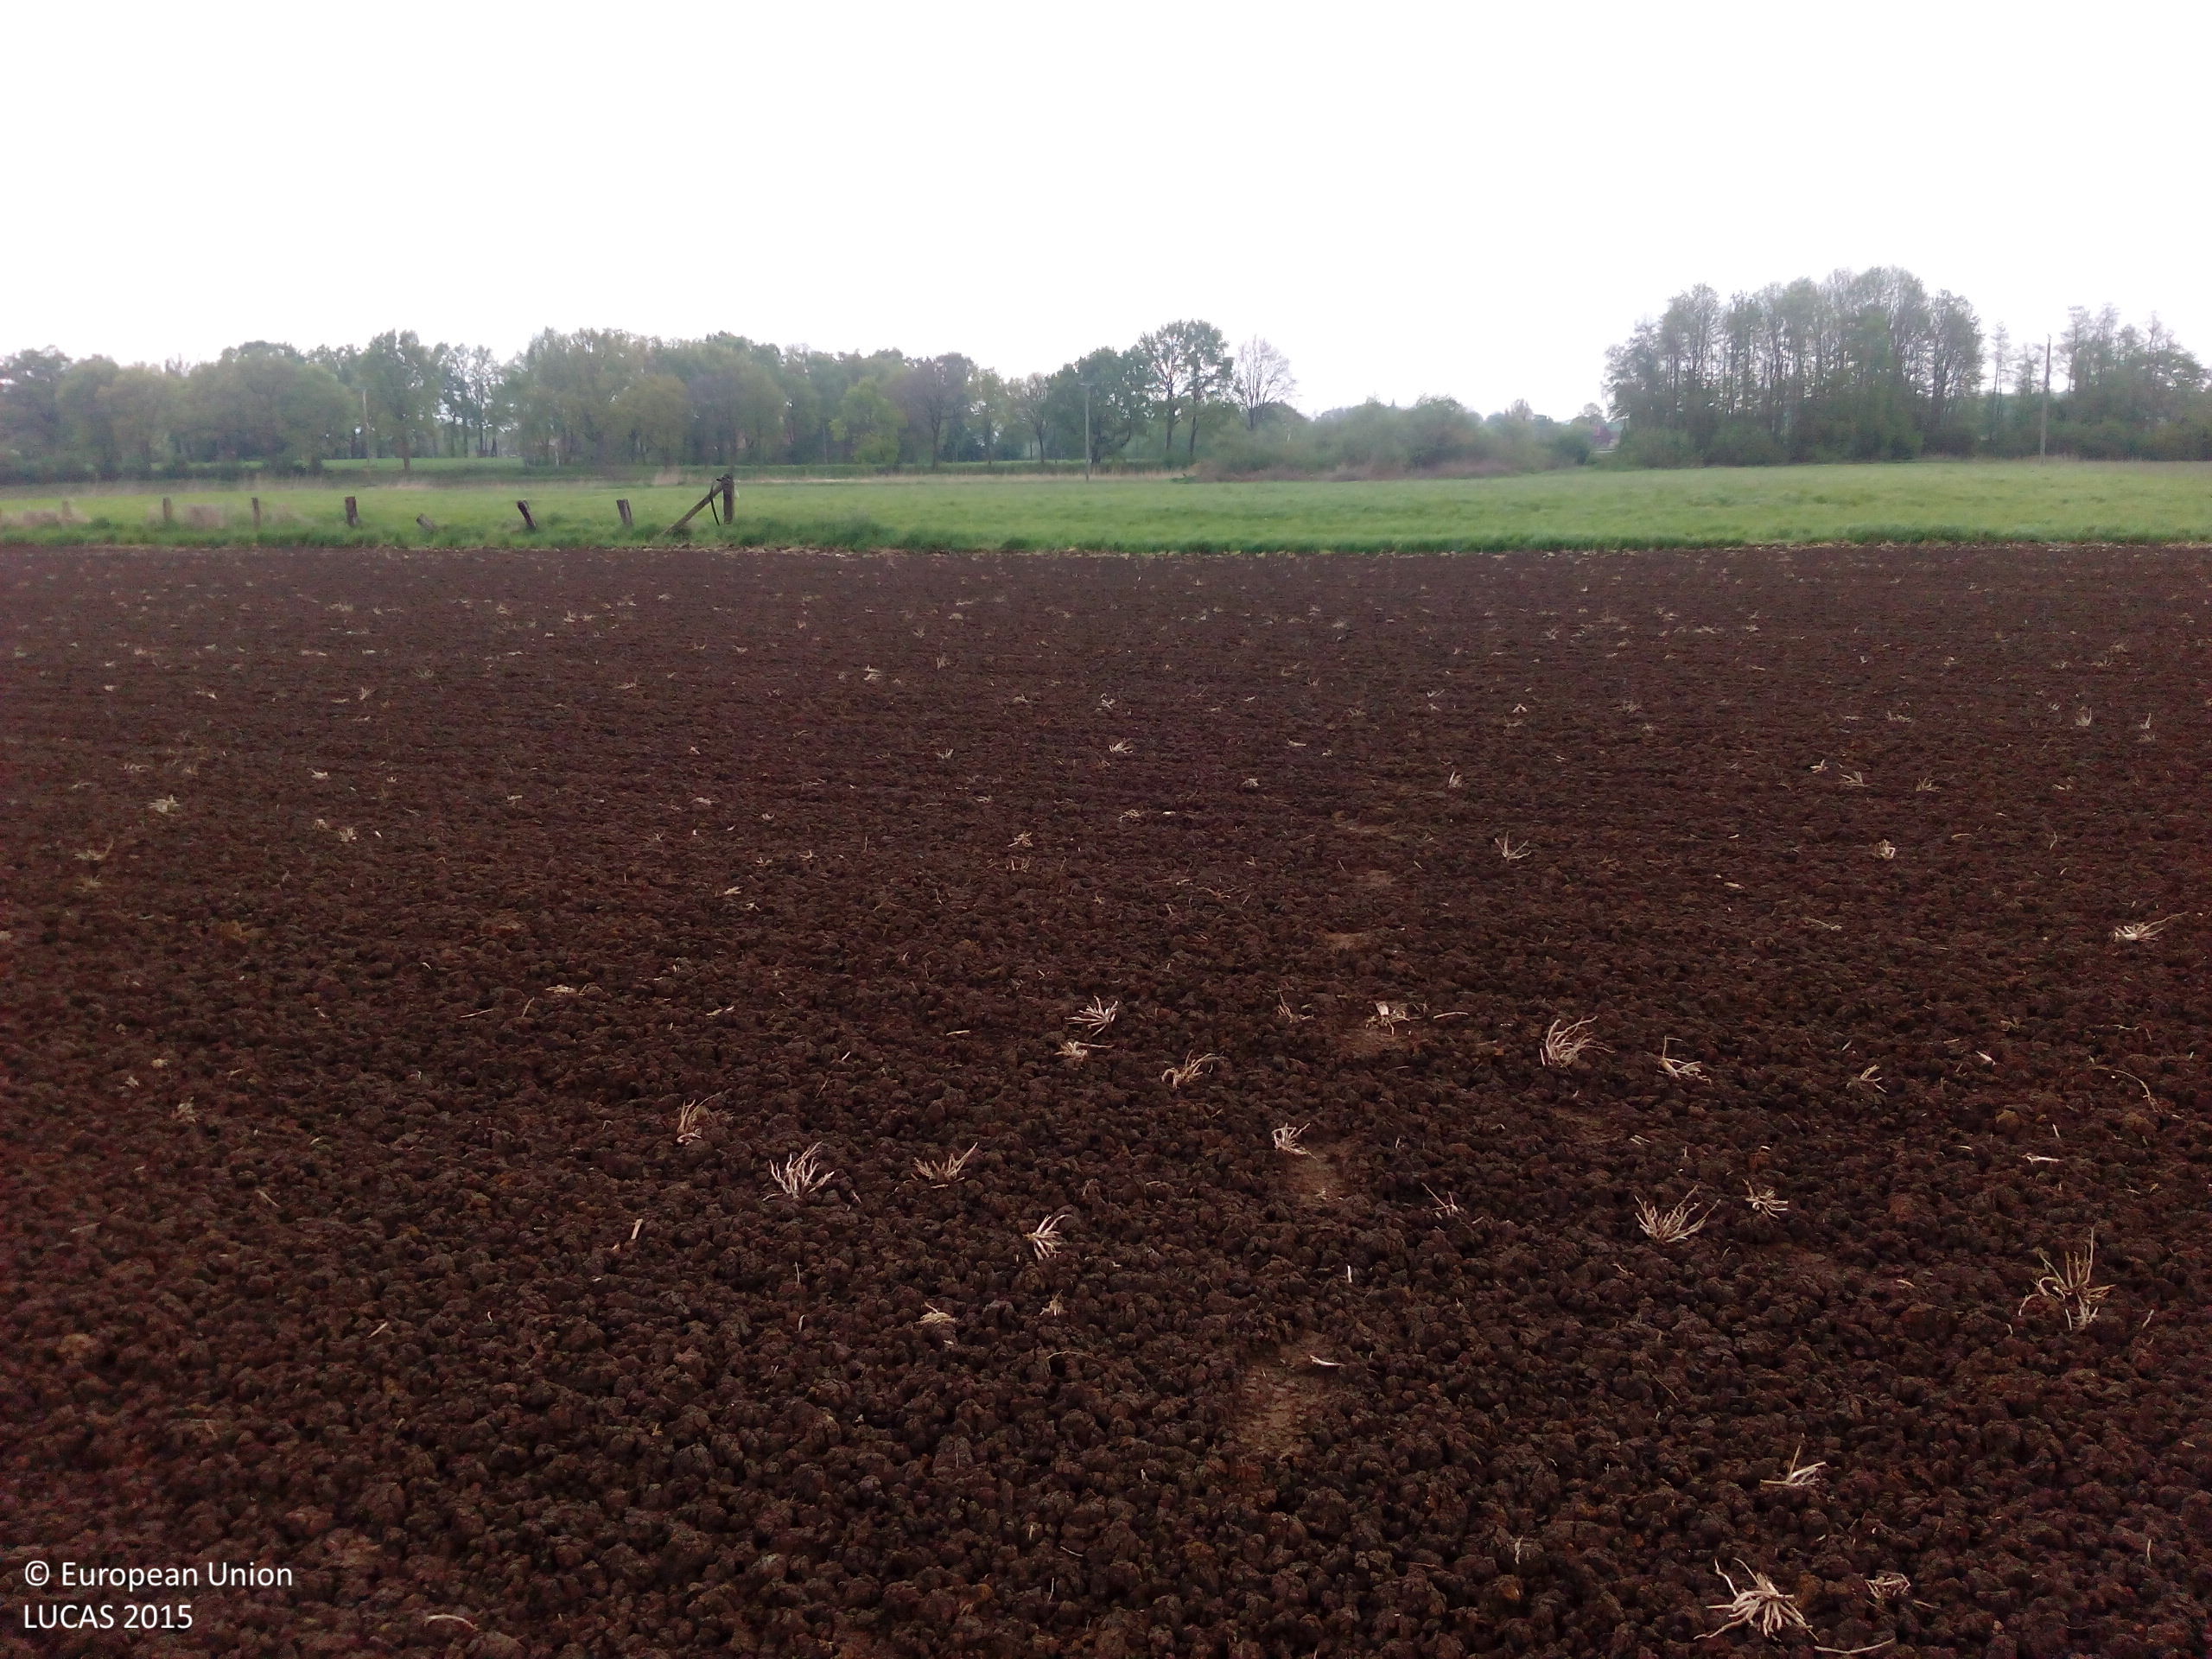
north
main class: Cropland
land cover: Maize
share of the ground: < 10 %
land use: Agriculture (excluding fallow land and kitchen gardens)
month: May
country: DE
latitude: 51.7191
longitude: 7.3802
